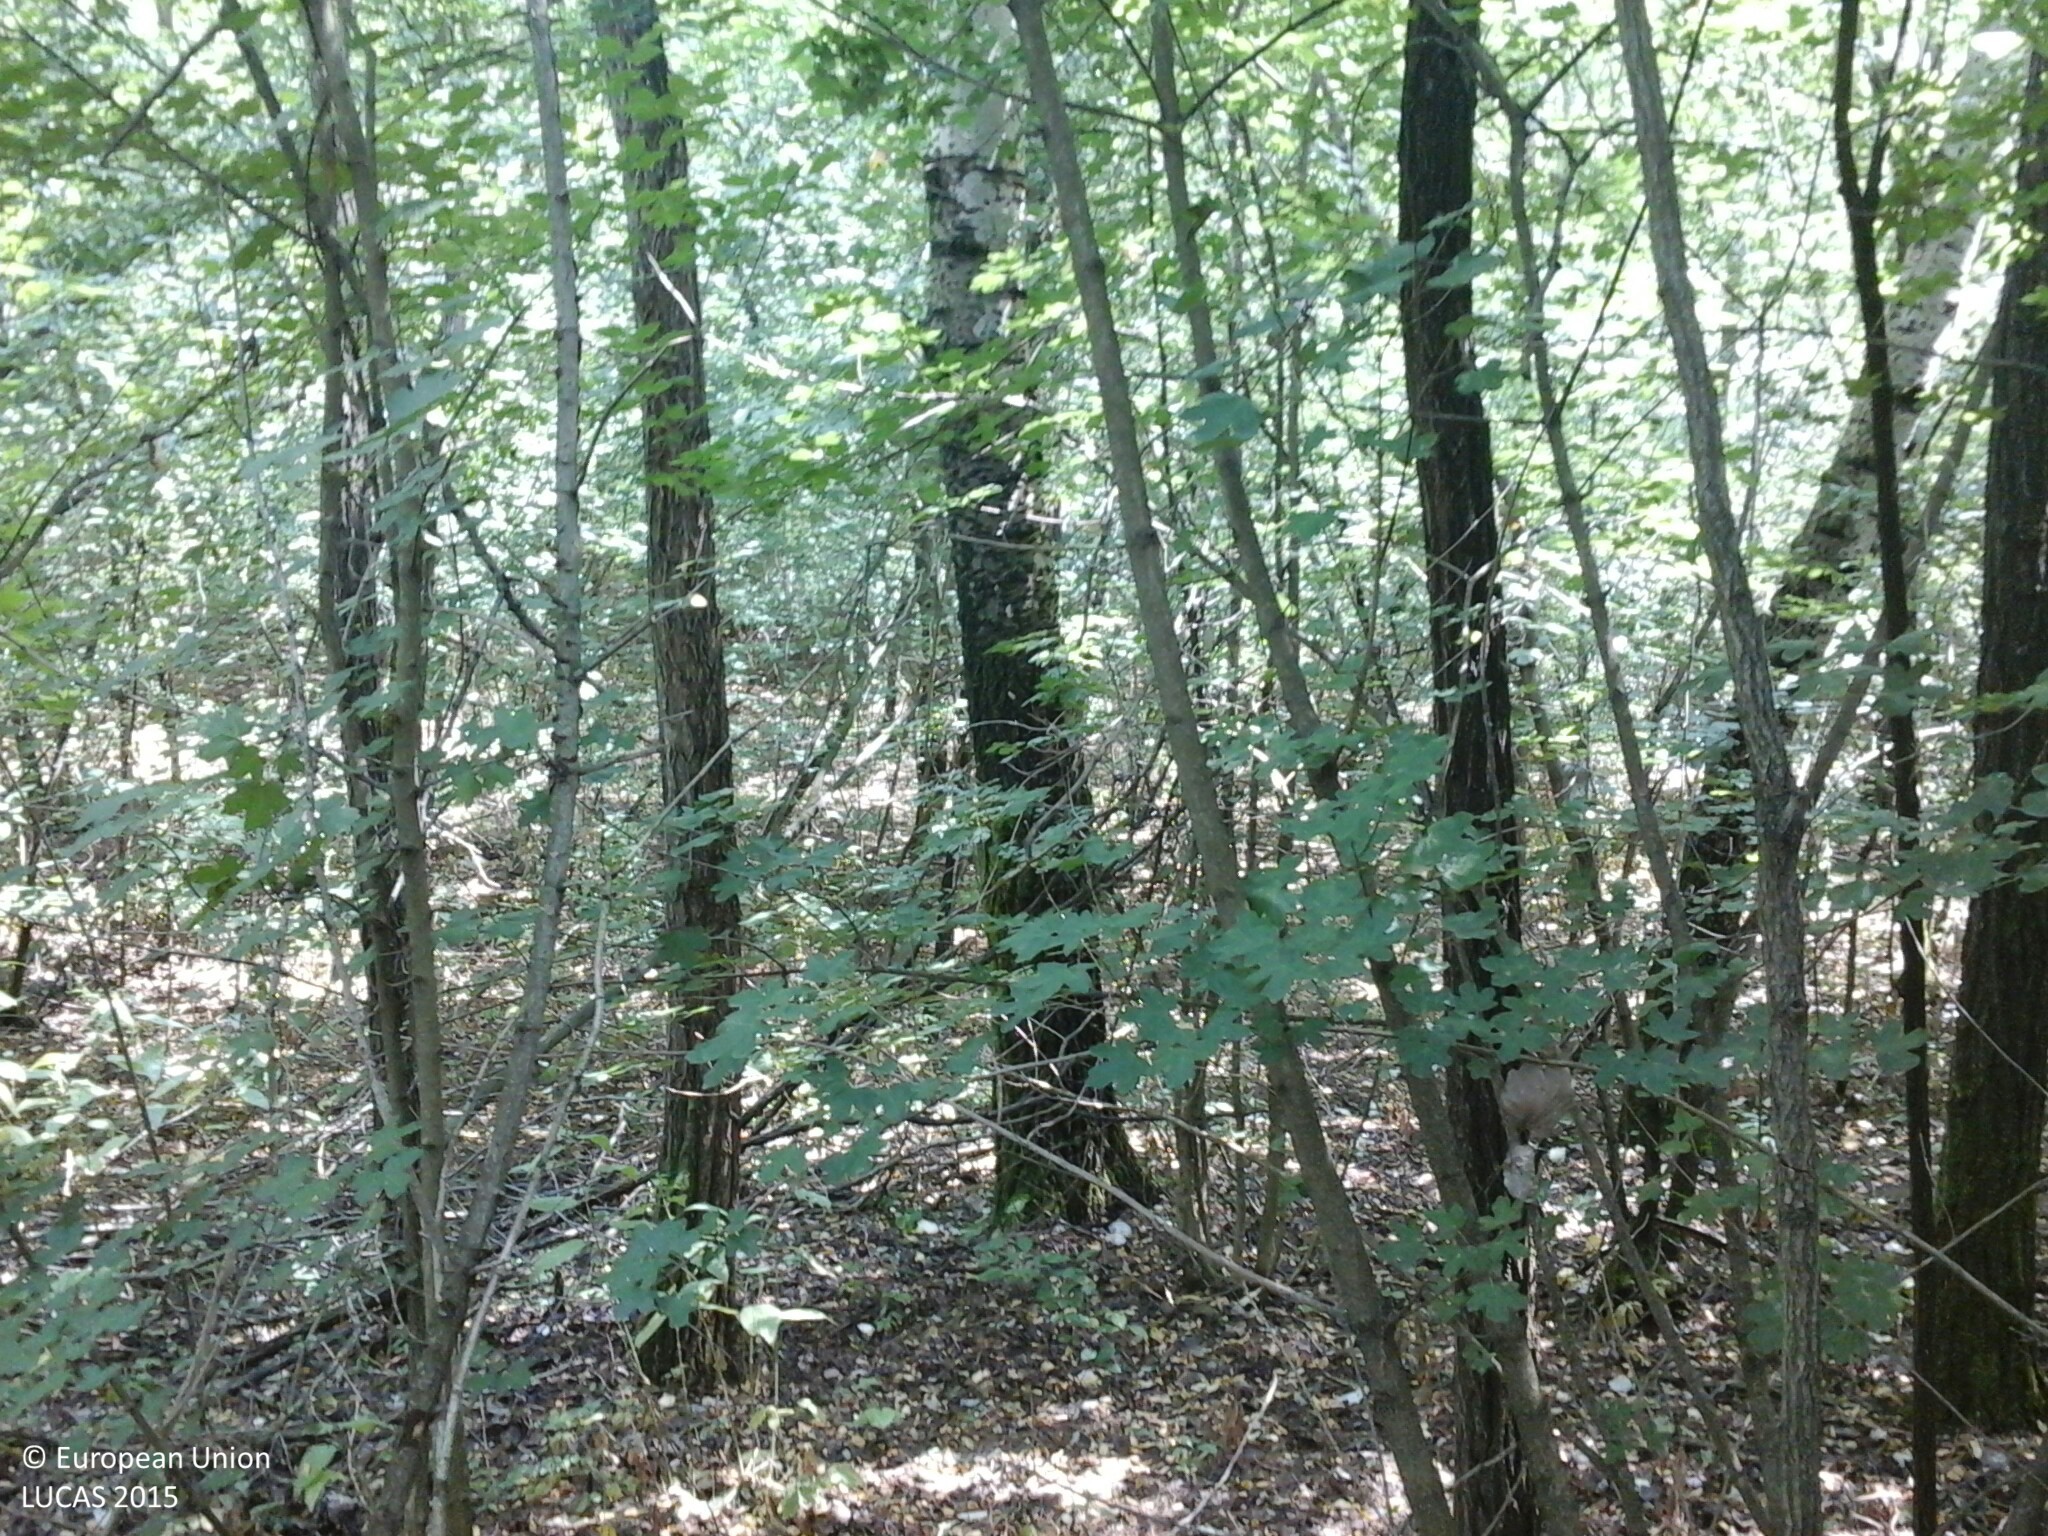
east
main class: Woodland
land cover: Broadleaved woodland
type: mesophytic deciduous forest
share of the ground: > 75 %
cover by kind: broadleaved forest trees 100 %
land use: Forestry
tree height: > 5 m
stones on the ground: < 10 %
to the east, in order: Broadleaved woodland; Tracks; Broadleaved woodland
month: July
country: HU
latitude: 48.2329
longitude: 22.2135
